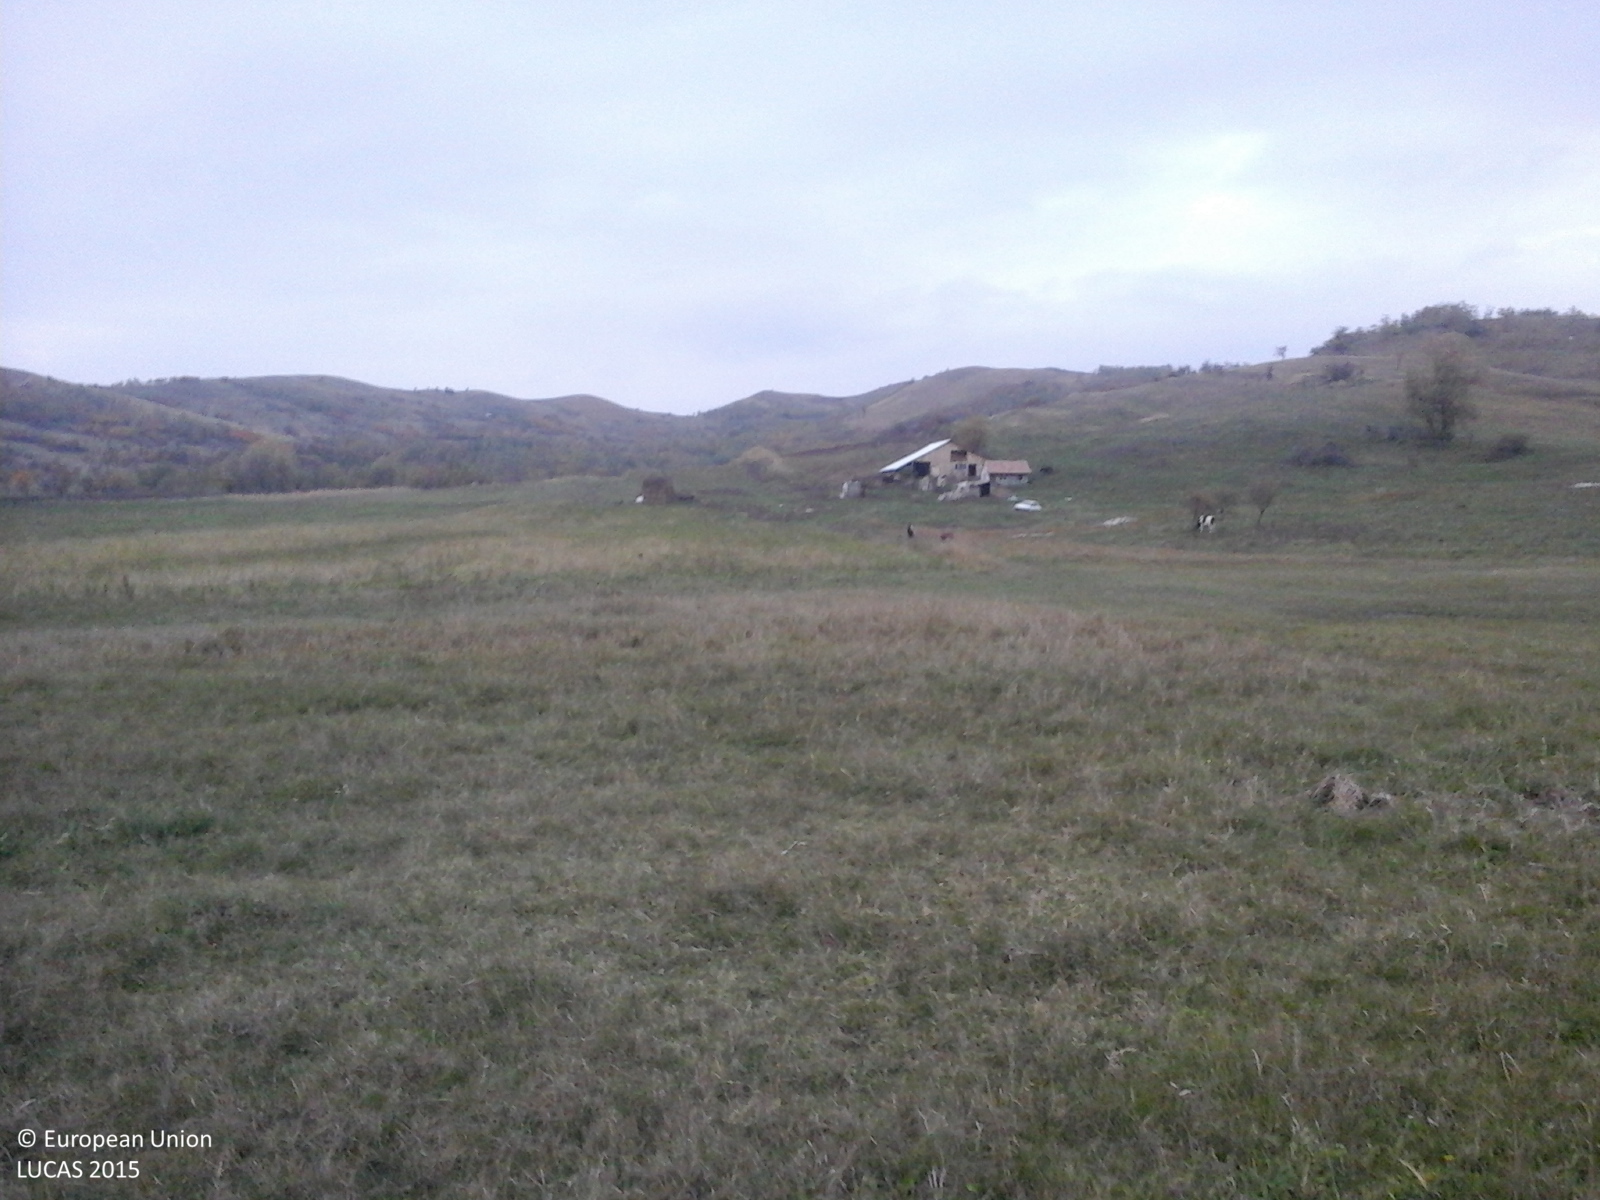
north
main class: Grassland
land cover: Grassland without tree/shrub cover
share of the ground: > 75 %
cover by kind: herbaceous plants 100 %
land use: Agriculture (excluding fallow land and kitchen gardens)
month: October
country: RO
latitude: 45.3958
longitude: 26.8028
